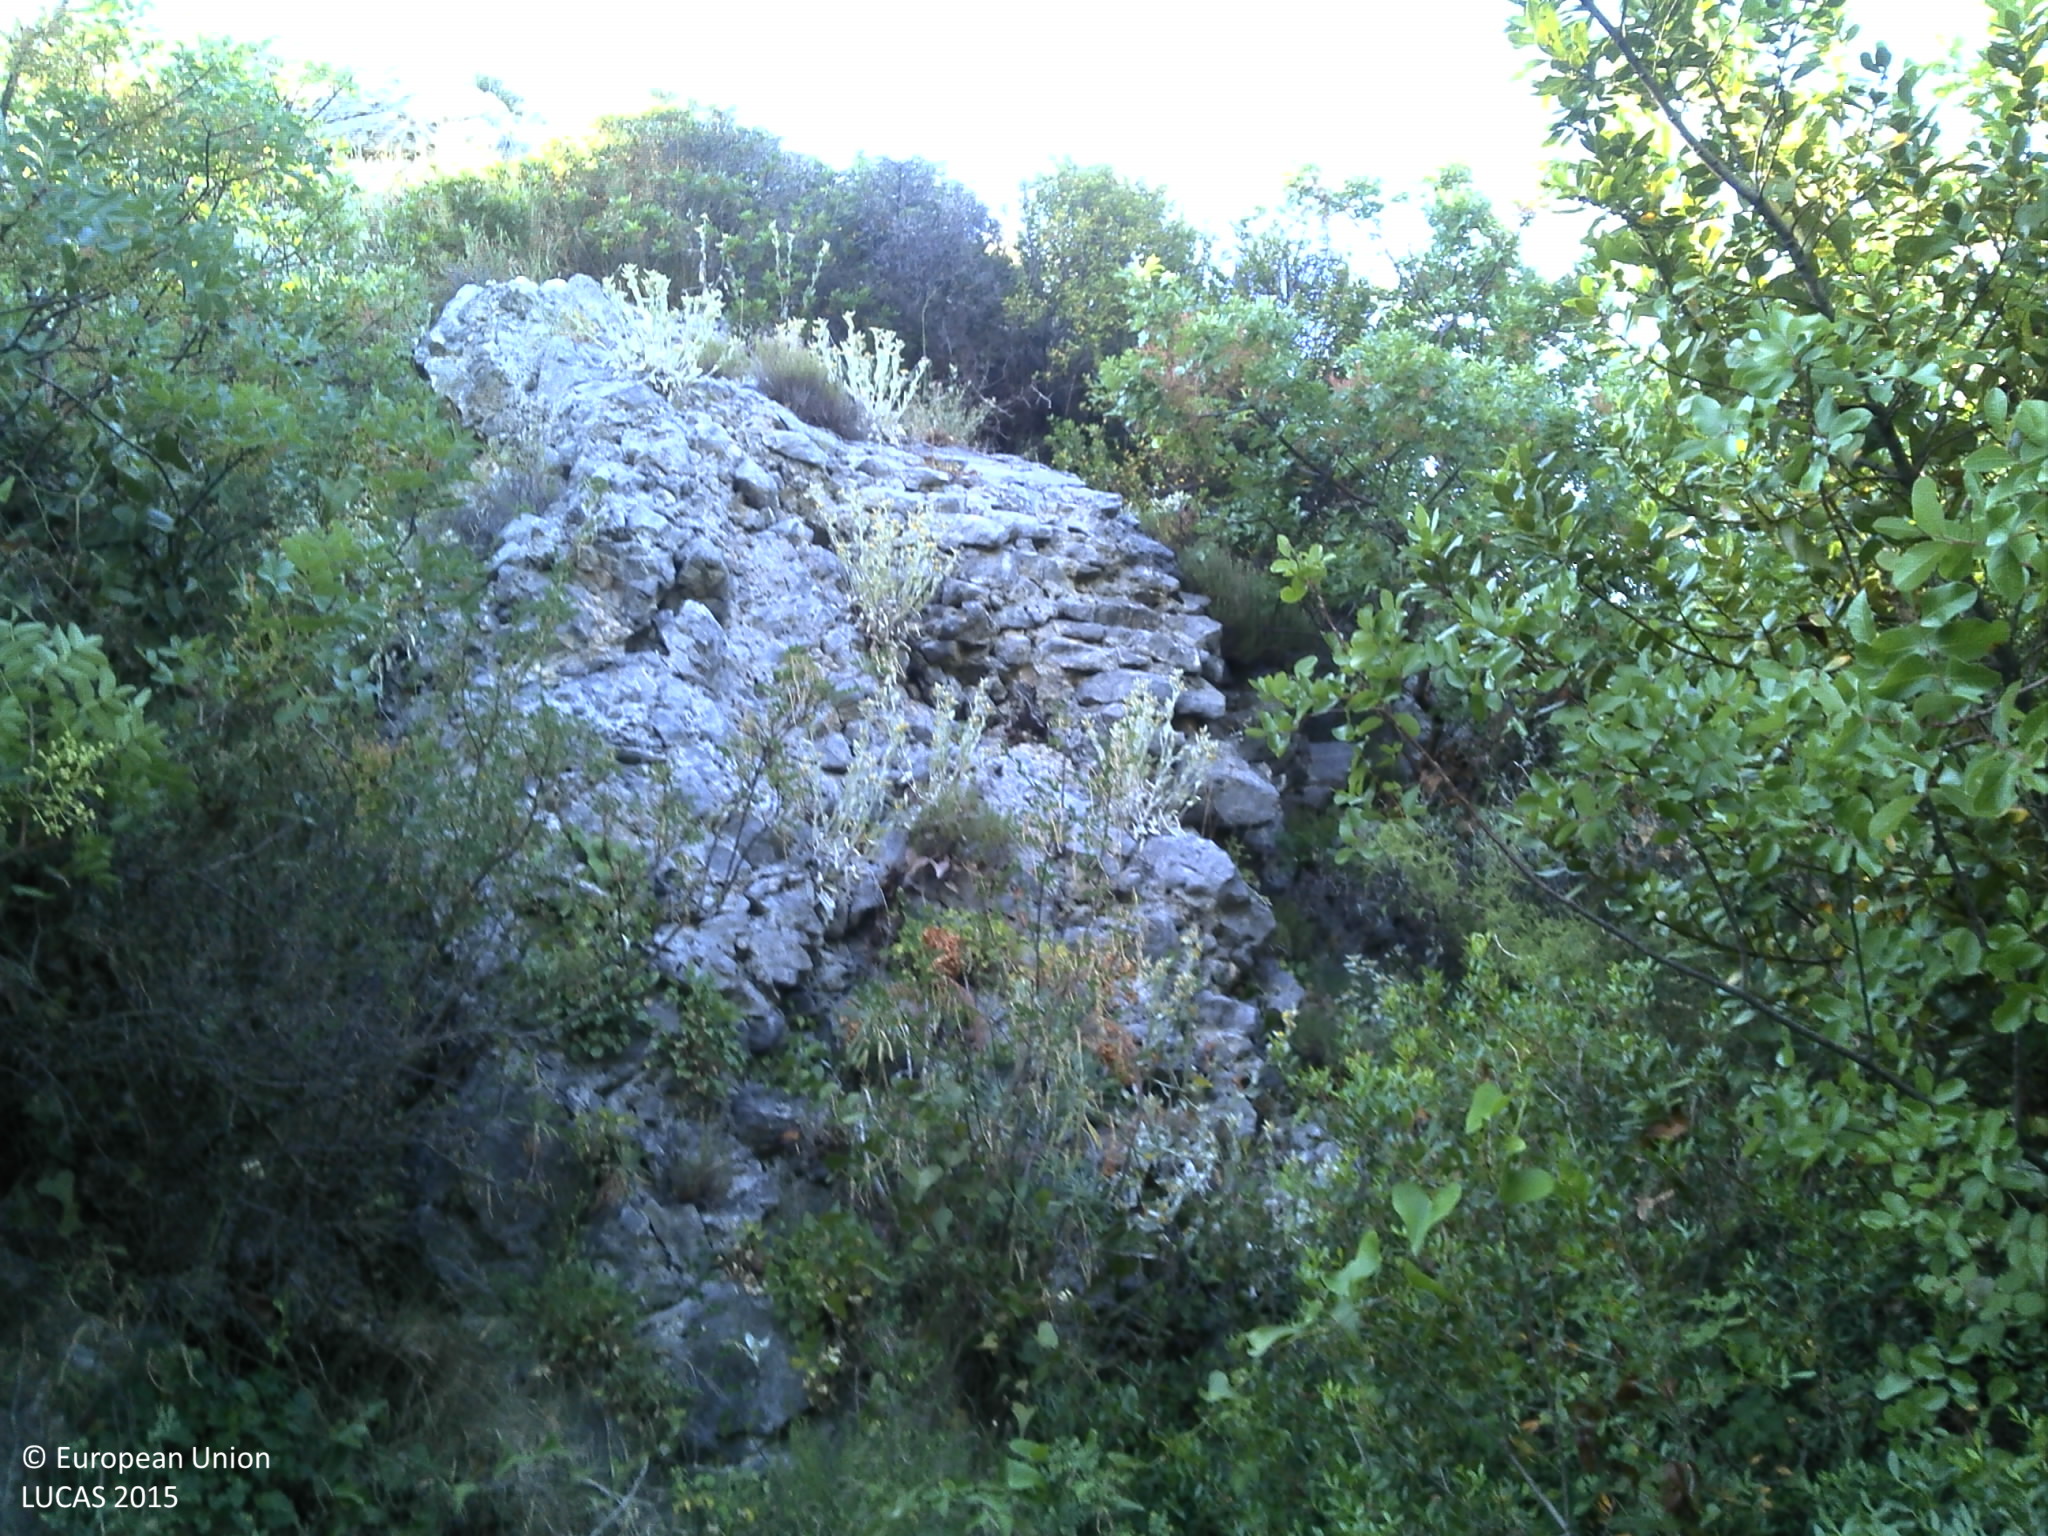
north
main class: Shrubland
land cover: Shrubland with sparse tree cover
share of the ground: 50 - 75 %
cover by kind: shrubs 60 %, herbaceous plants 15 %, unconsolidated bare surface 15 %, broadleaved forest trees 5 %, consolidated bare surface 5 %
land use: Semi-natural and natural areas not in use
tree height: < 5 m
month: July
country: HR
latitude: 42.6298
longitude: 18.1968
